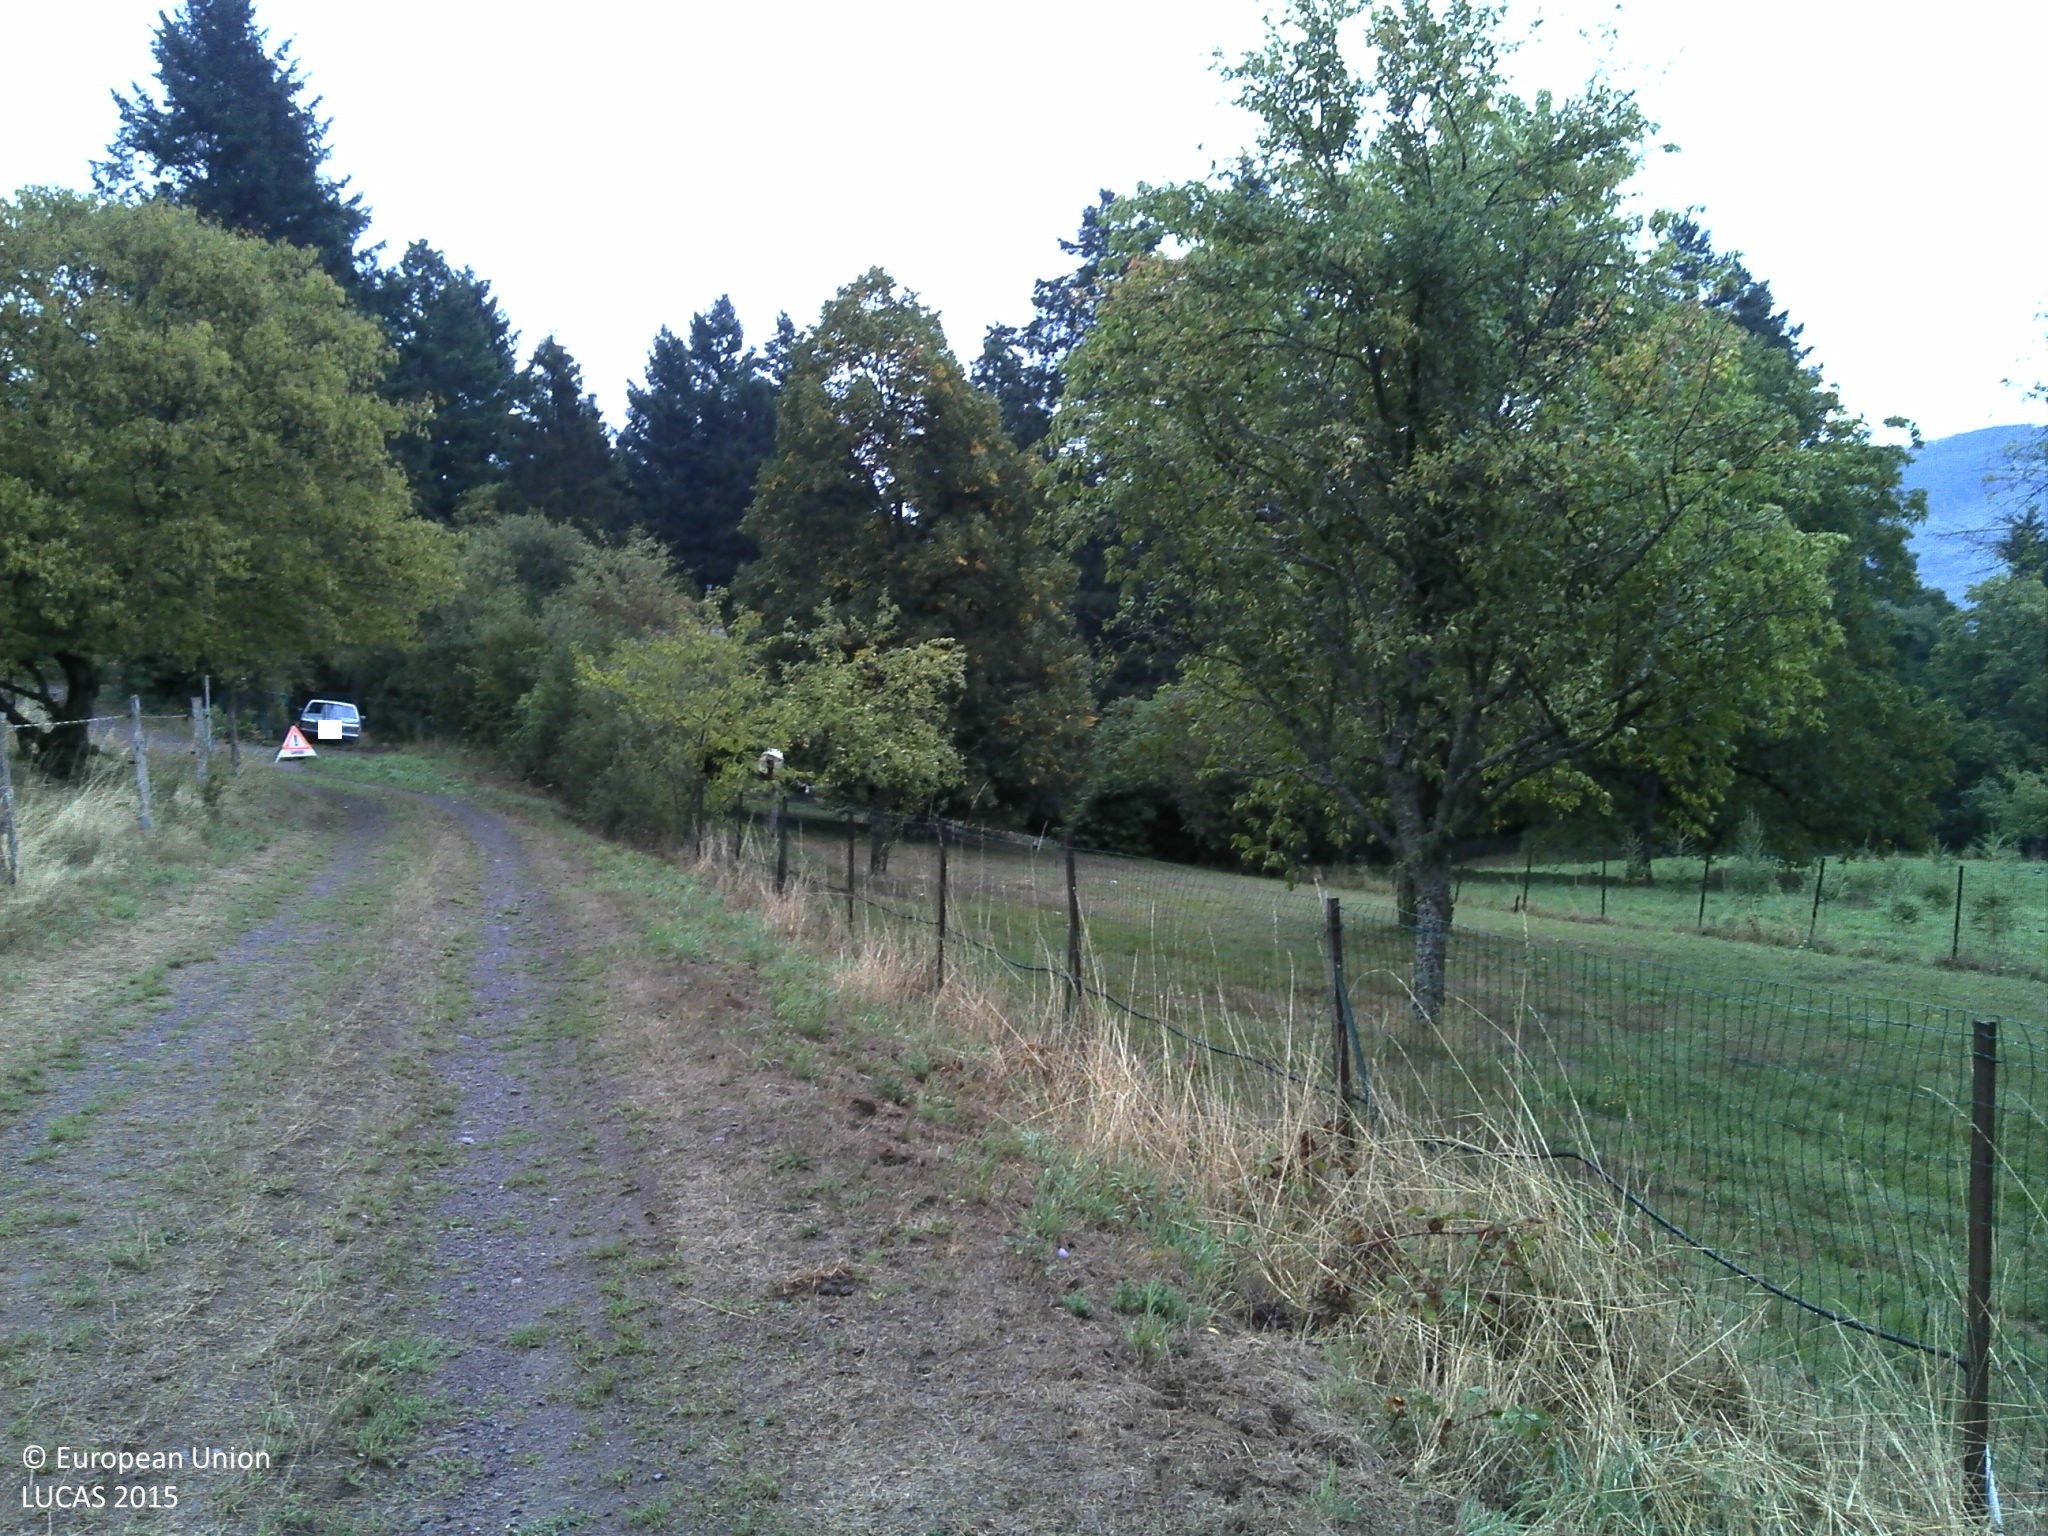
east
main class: Grassland
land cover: Grassland without tree/shrub cover
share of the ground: > 75 %
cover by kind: herbaceous plants 100 %
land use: Agriculture (excluding fallow land and kitchen gardens)
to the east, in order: Grassland without tree/shrub cover; Broadleaved woodland; Grassland with sparse tree/shrub cover; Broadleaved woodland; Grassland with sparse tree/shrub cover; Artificial constructions in urban areas; Broadleaved woodland
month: September
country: FR
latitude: 48.5141
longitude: 7.2798
